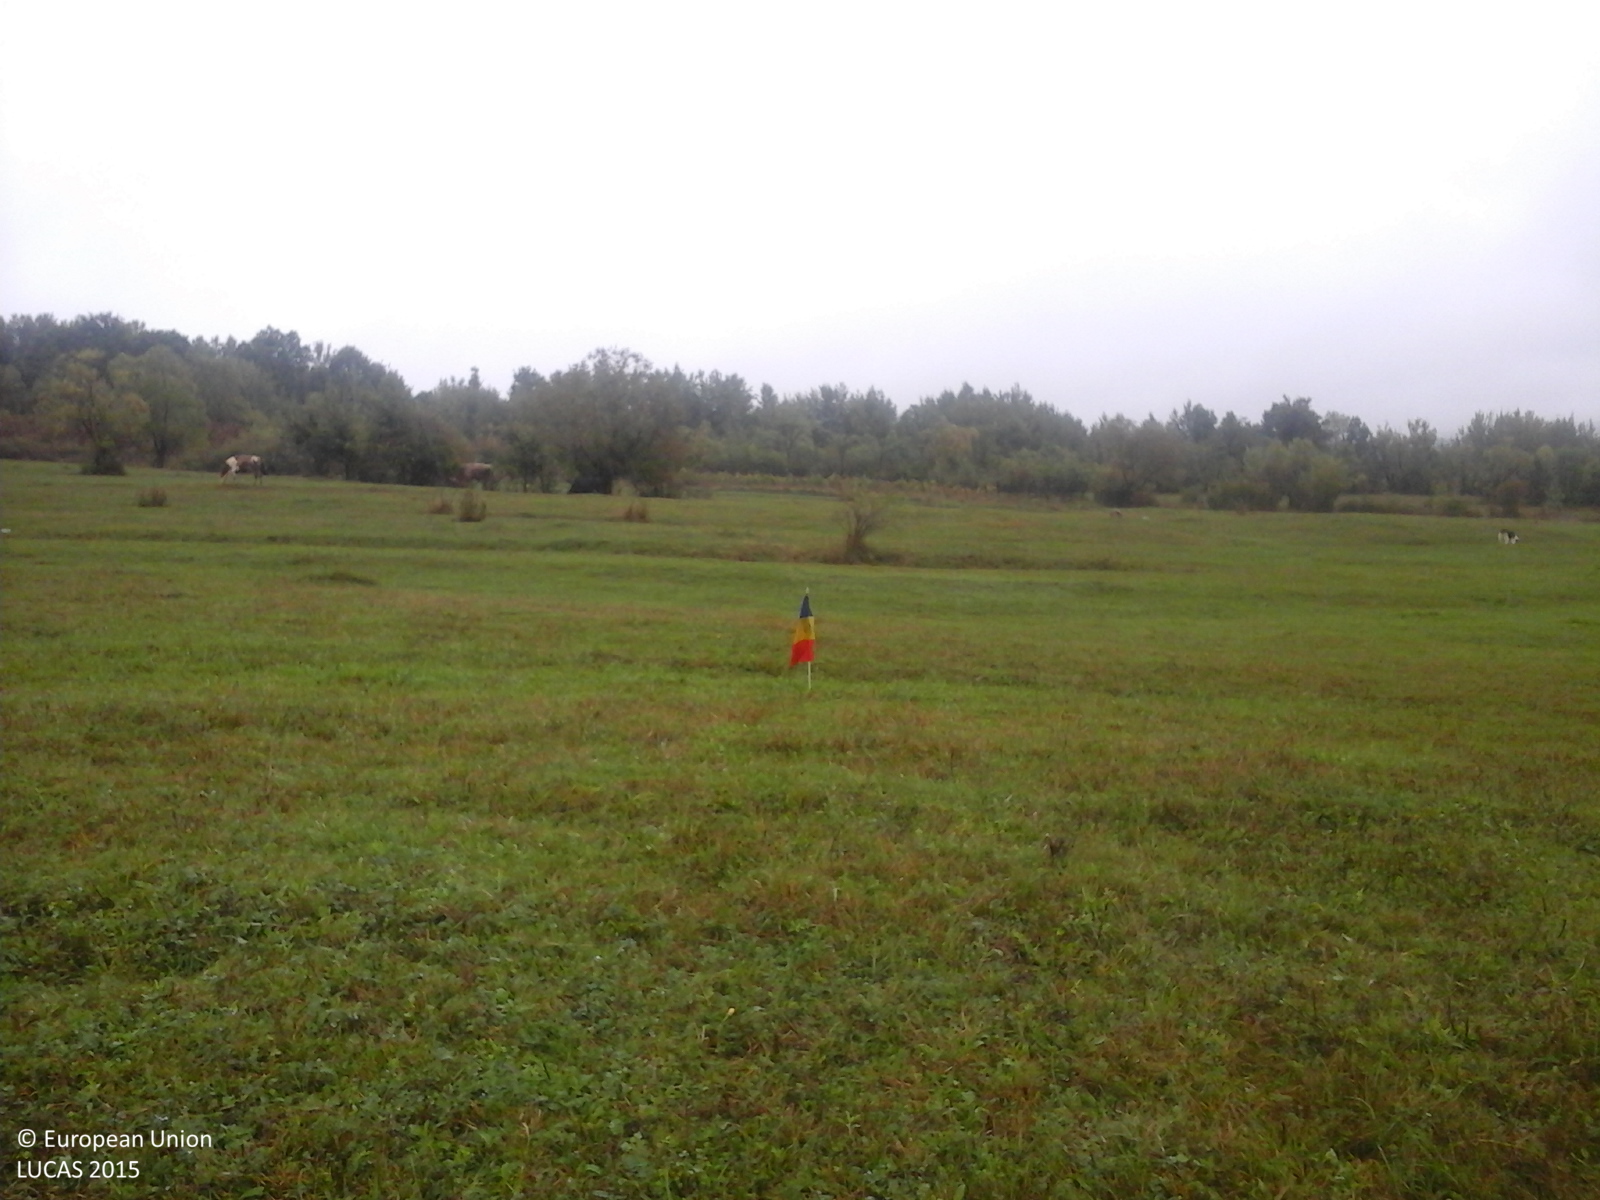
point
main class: Grassland
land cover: Grassland without tree/shrub cover
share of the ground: > 75 %
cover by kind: herbaceous plants 100 %
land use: Agriculture (excluding fallow land and kitchen gardens)
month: September
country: RO
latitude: 45.1451
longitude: 23.6307
